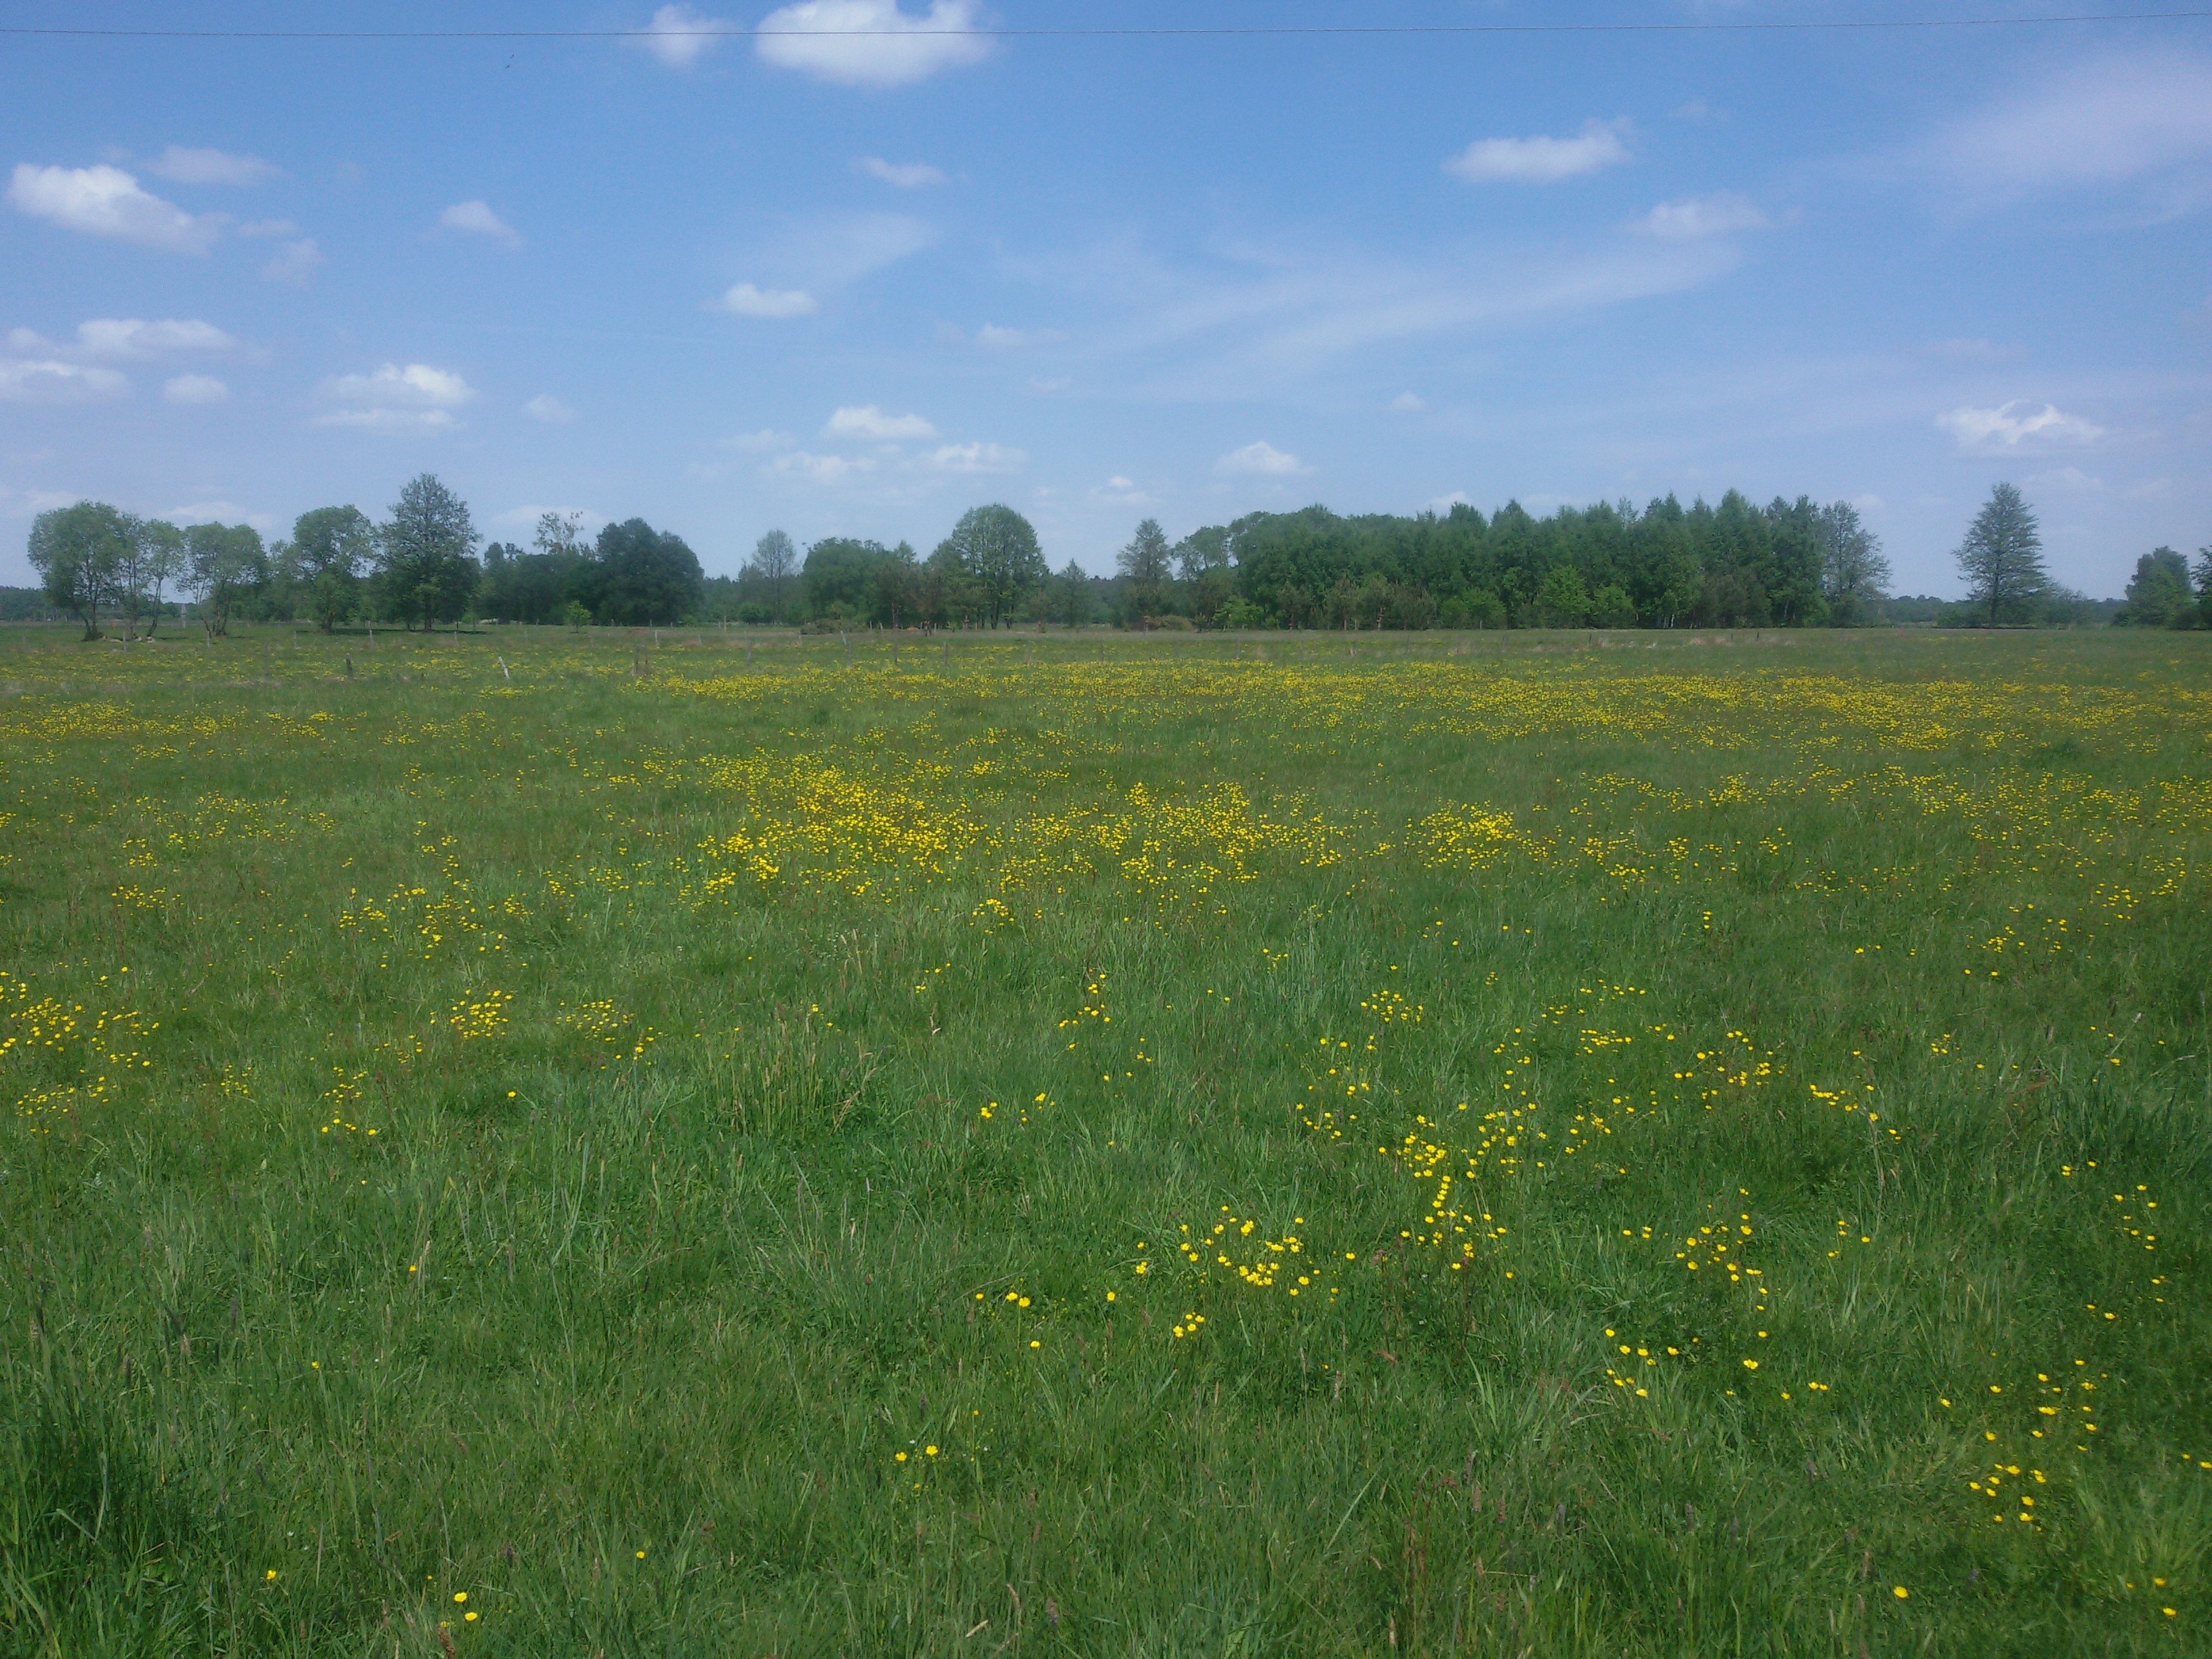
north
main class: Grassland
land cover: Grassland without tree/shrub cover
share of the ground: > 75 %
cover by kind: herbaceous plants 100 %
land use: Agriculture (excluding fallow land and kitchen gardens)
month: May
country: PL
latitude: 53.1169
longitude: 21.3892
